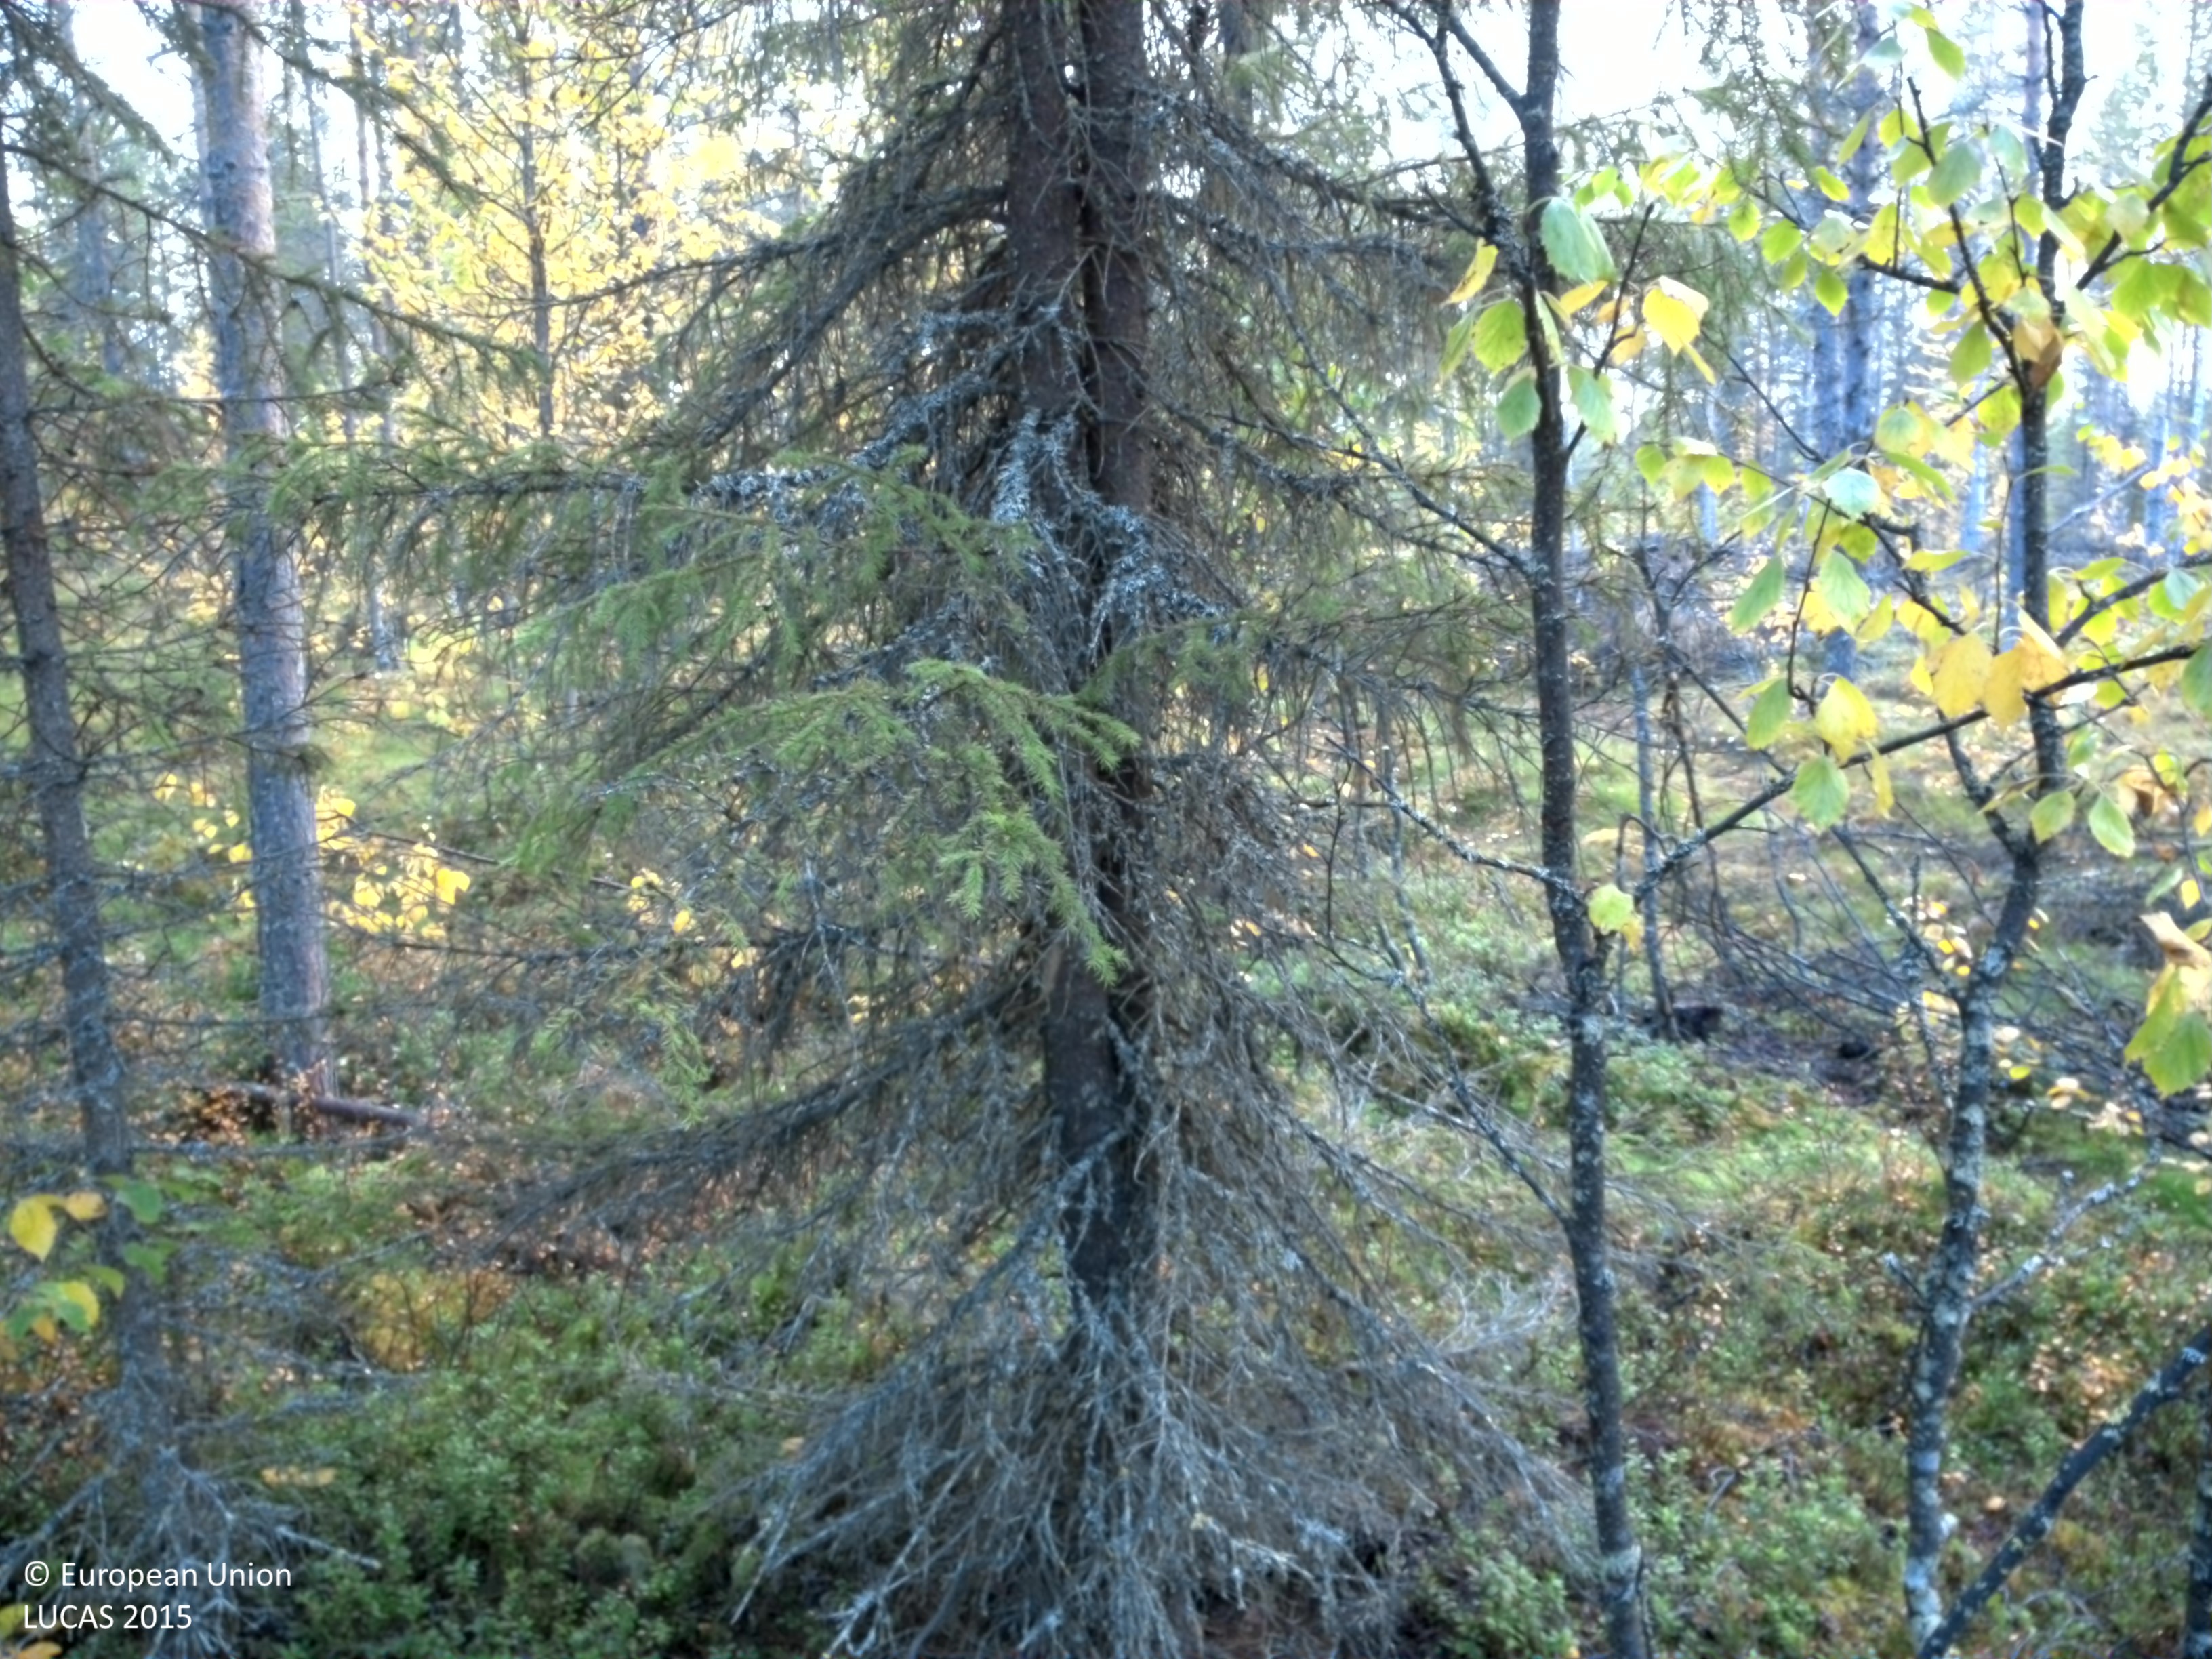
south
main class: Woodland
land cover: Pine dominated mixed woodland
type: boreal forest
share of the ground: 25 - 50 %
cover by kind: shrubs 35 %, coniferous forest trees 25 %, lichens and mosses 15 %, broadleaved forest trees 10 %, herbaceous plants 10 %
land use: Forestry
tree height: > 5 m
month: September
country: SE
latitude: 65.2232
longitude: 16.5711
